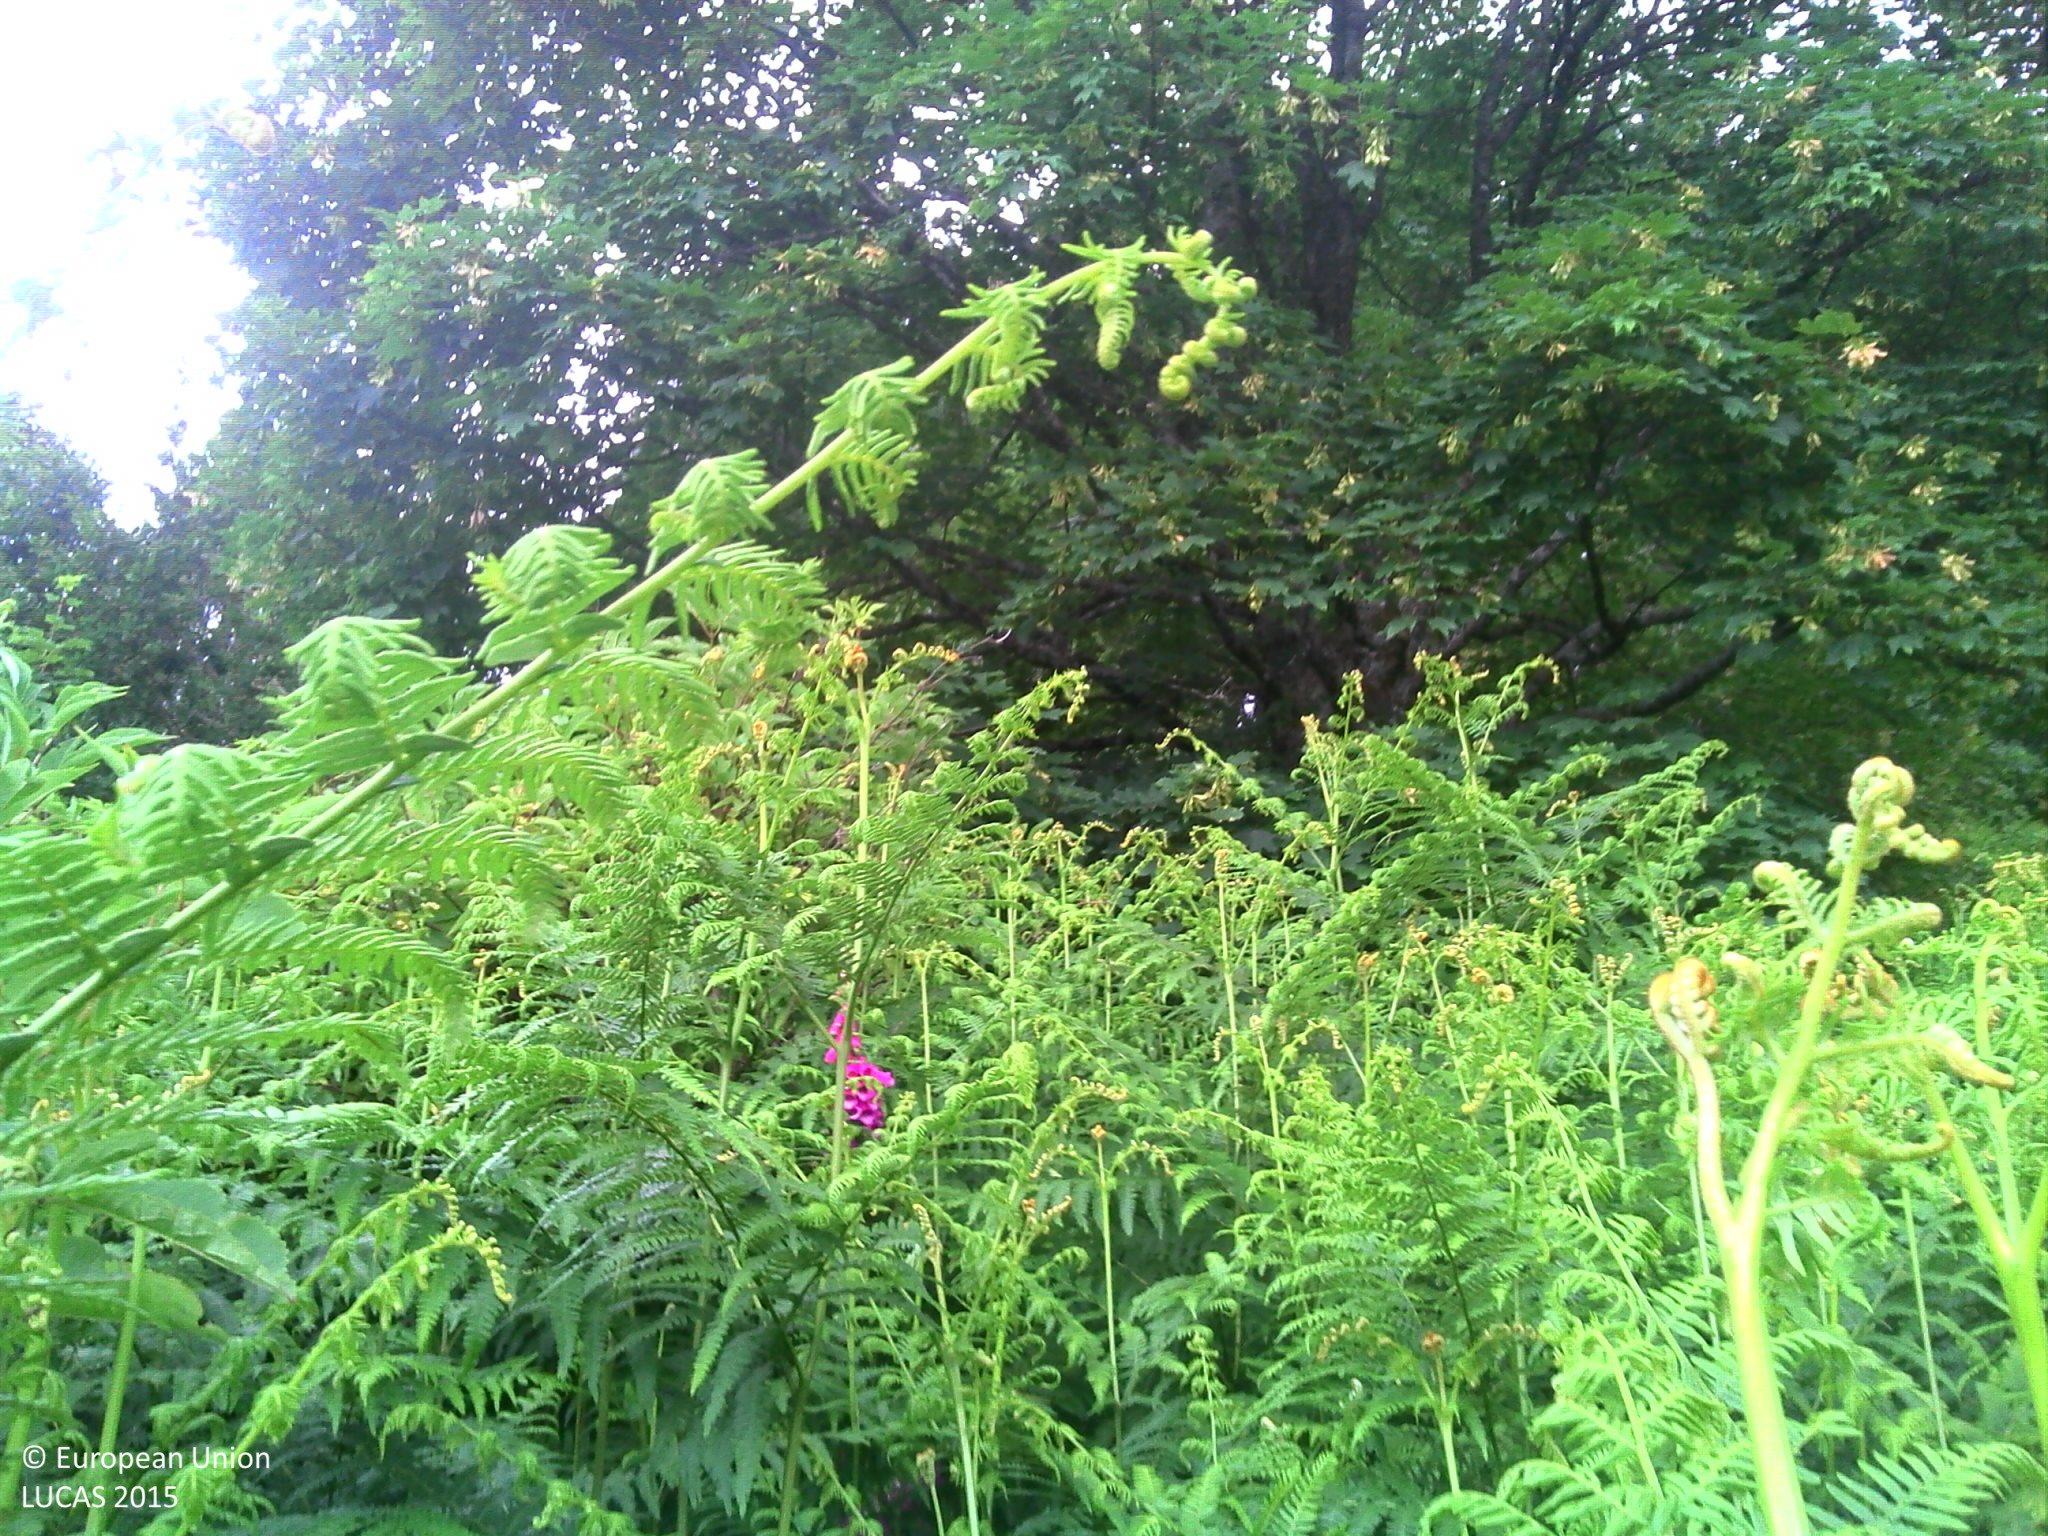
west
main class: Shrubland
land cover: Shrubland without tree cover
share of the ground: > 75 %
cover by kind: shrubs 100 %
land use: Abandoned areas
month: June
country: FR
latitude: 47.9186
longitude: 6.5888
